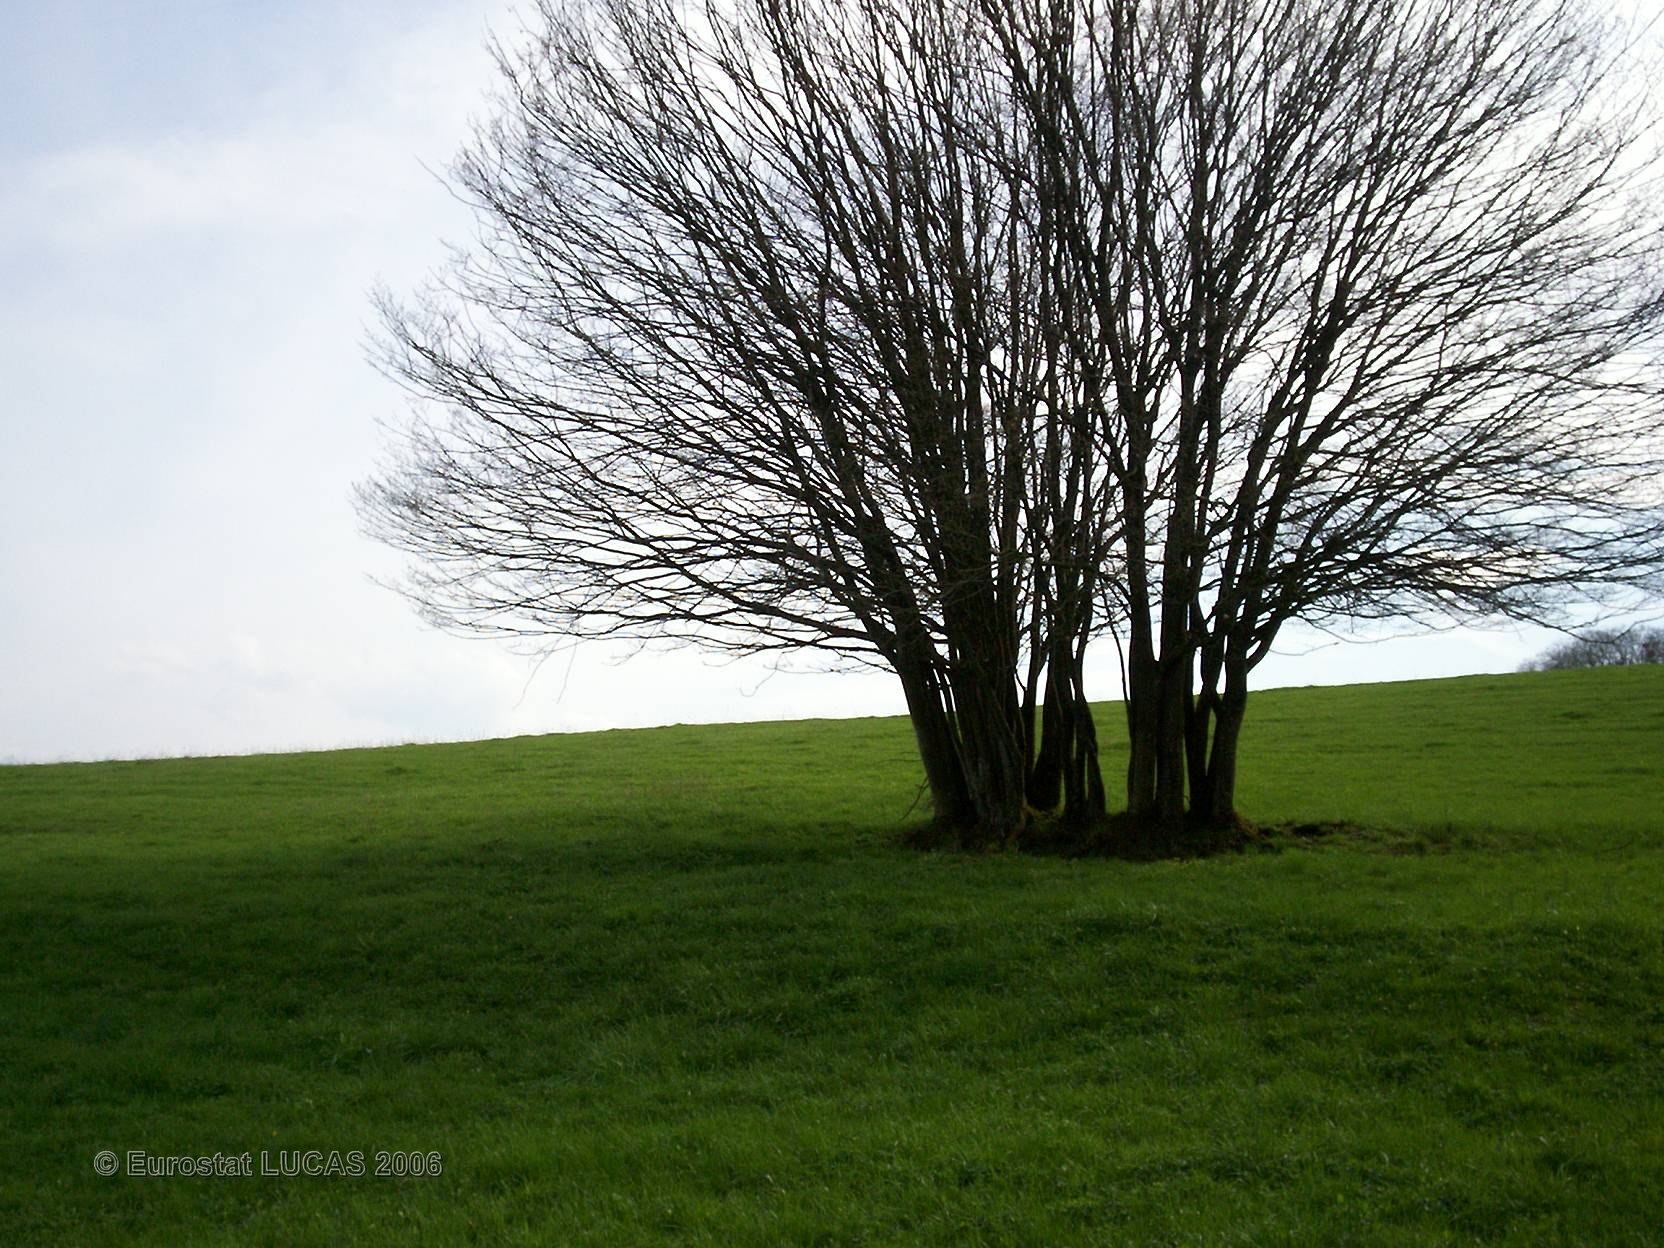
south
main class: Grassland
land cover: Grassland without tree/shrub cover
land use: Agriculture (excluding fallow land and kitchen gardens)
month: April
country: FR
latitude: 48.2137
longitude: 6.2457
